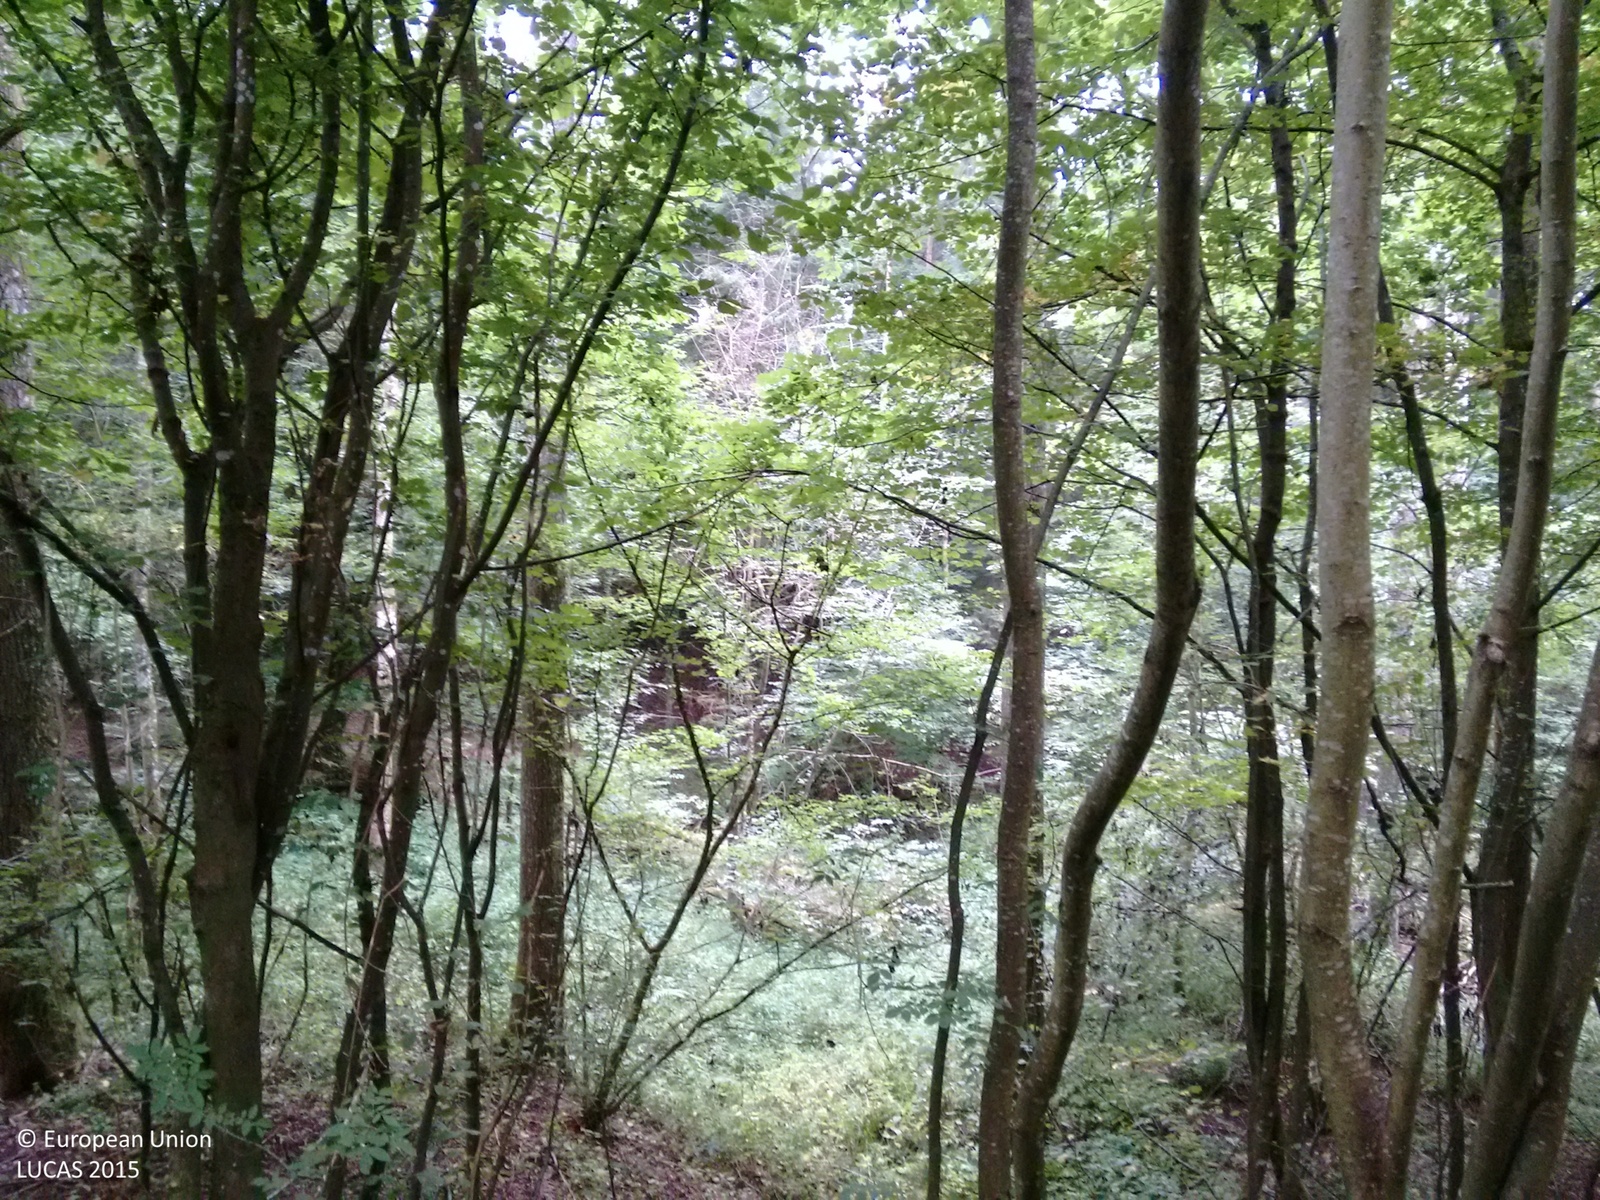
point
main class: Woodland
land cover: Broadleaved woodland
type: mesophytic deciduous forest
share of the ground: > 75 %
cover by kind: broadleaved forest trees 80 %, shrubs 20 %
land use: Semi-natural and natural areas not in use
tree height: > 5 m
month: September
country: GB
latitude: 52.0533
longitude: -3.2186
